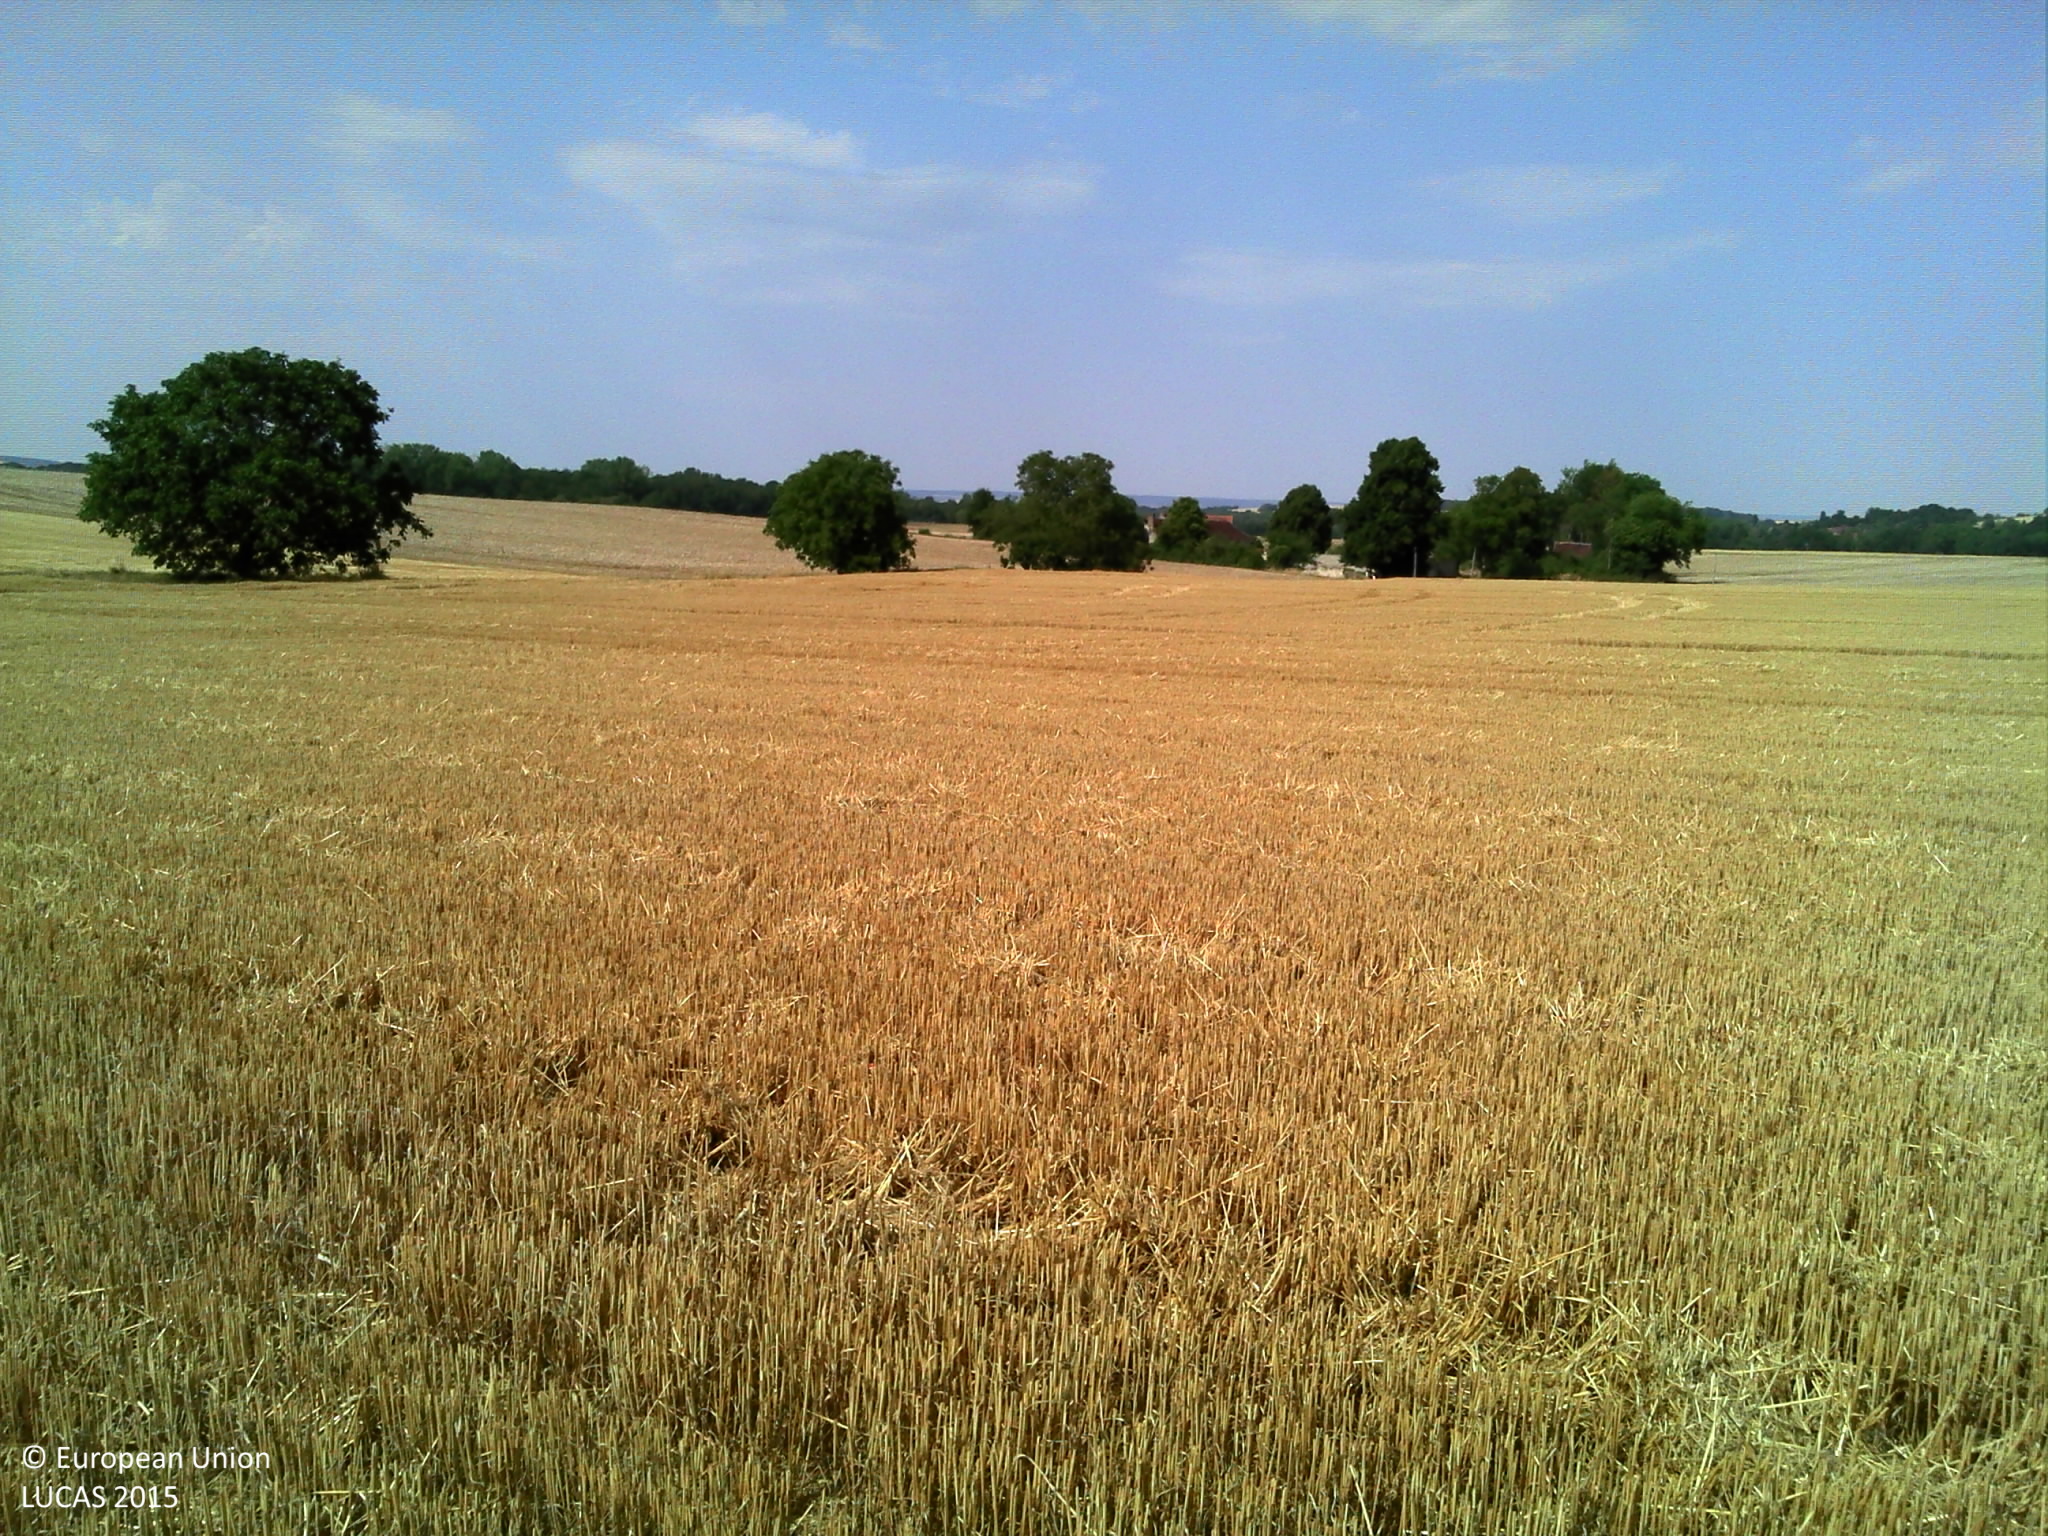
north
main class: Cropland
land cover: Common wheat
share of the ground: > 75 %
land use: Agriculture (excluding fallow land and kitchen gardens)
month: August
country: FR
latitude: 47.8472
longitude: 3.4337
